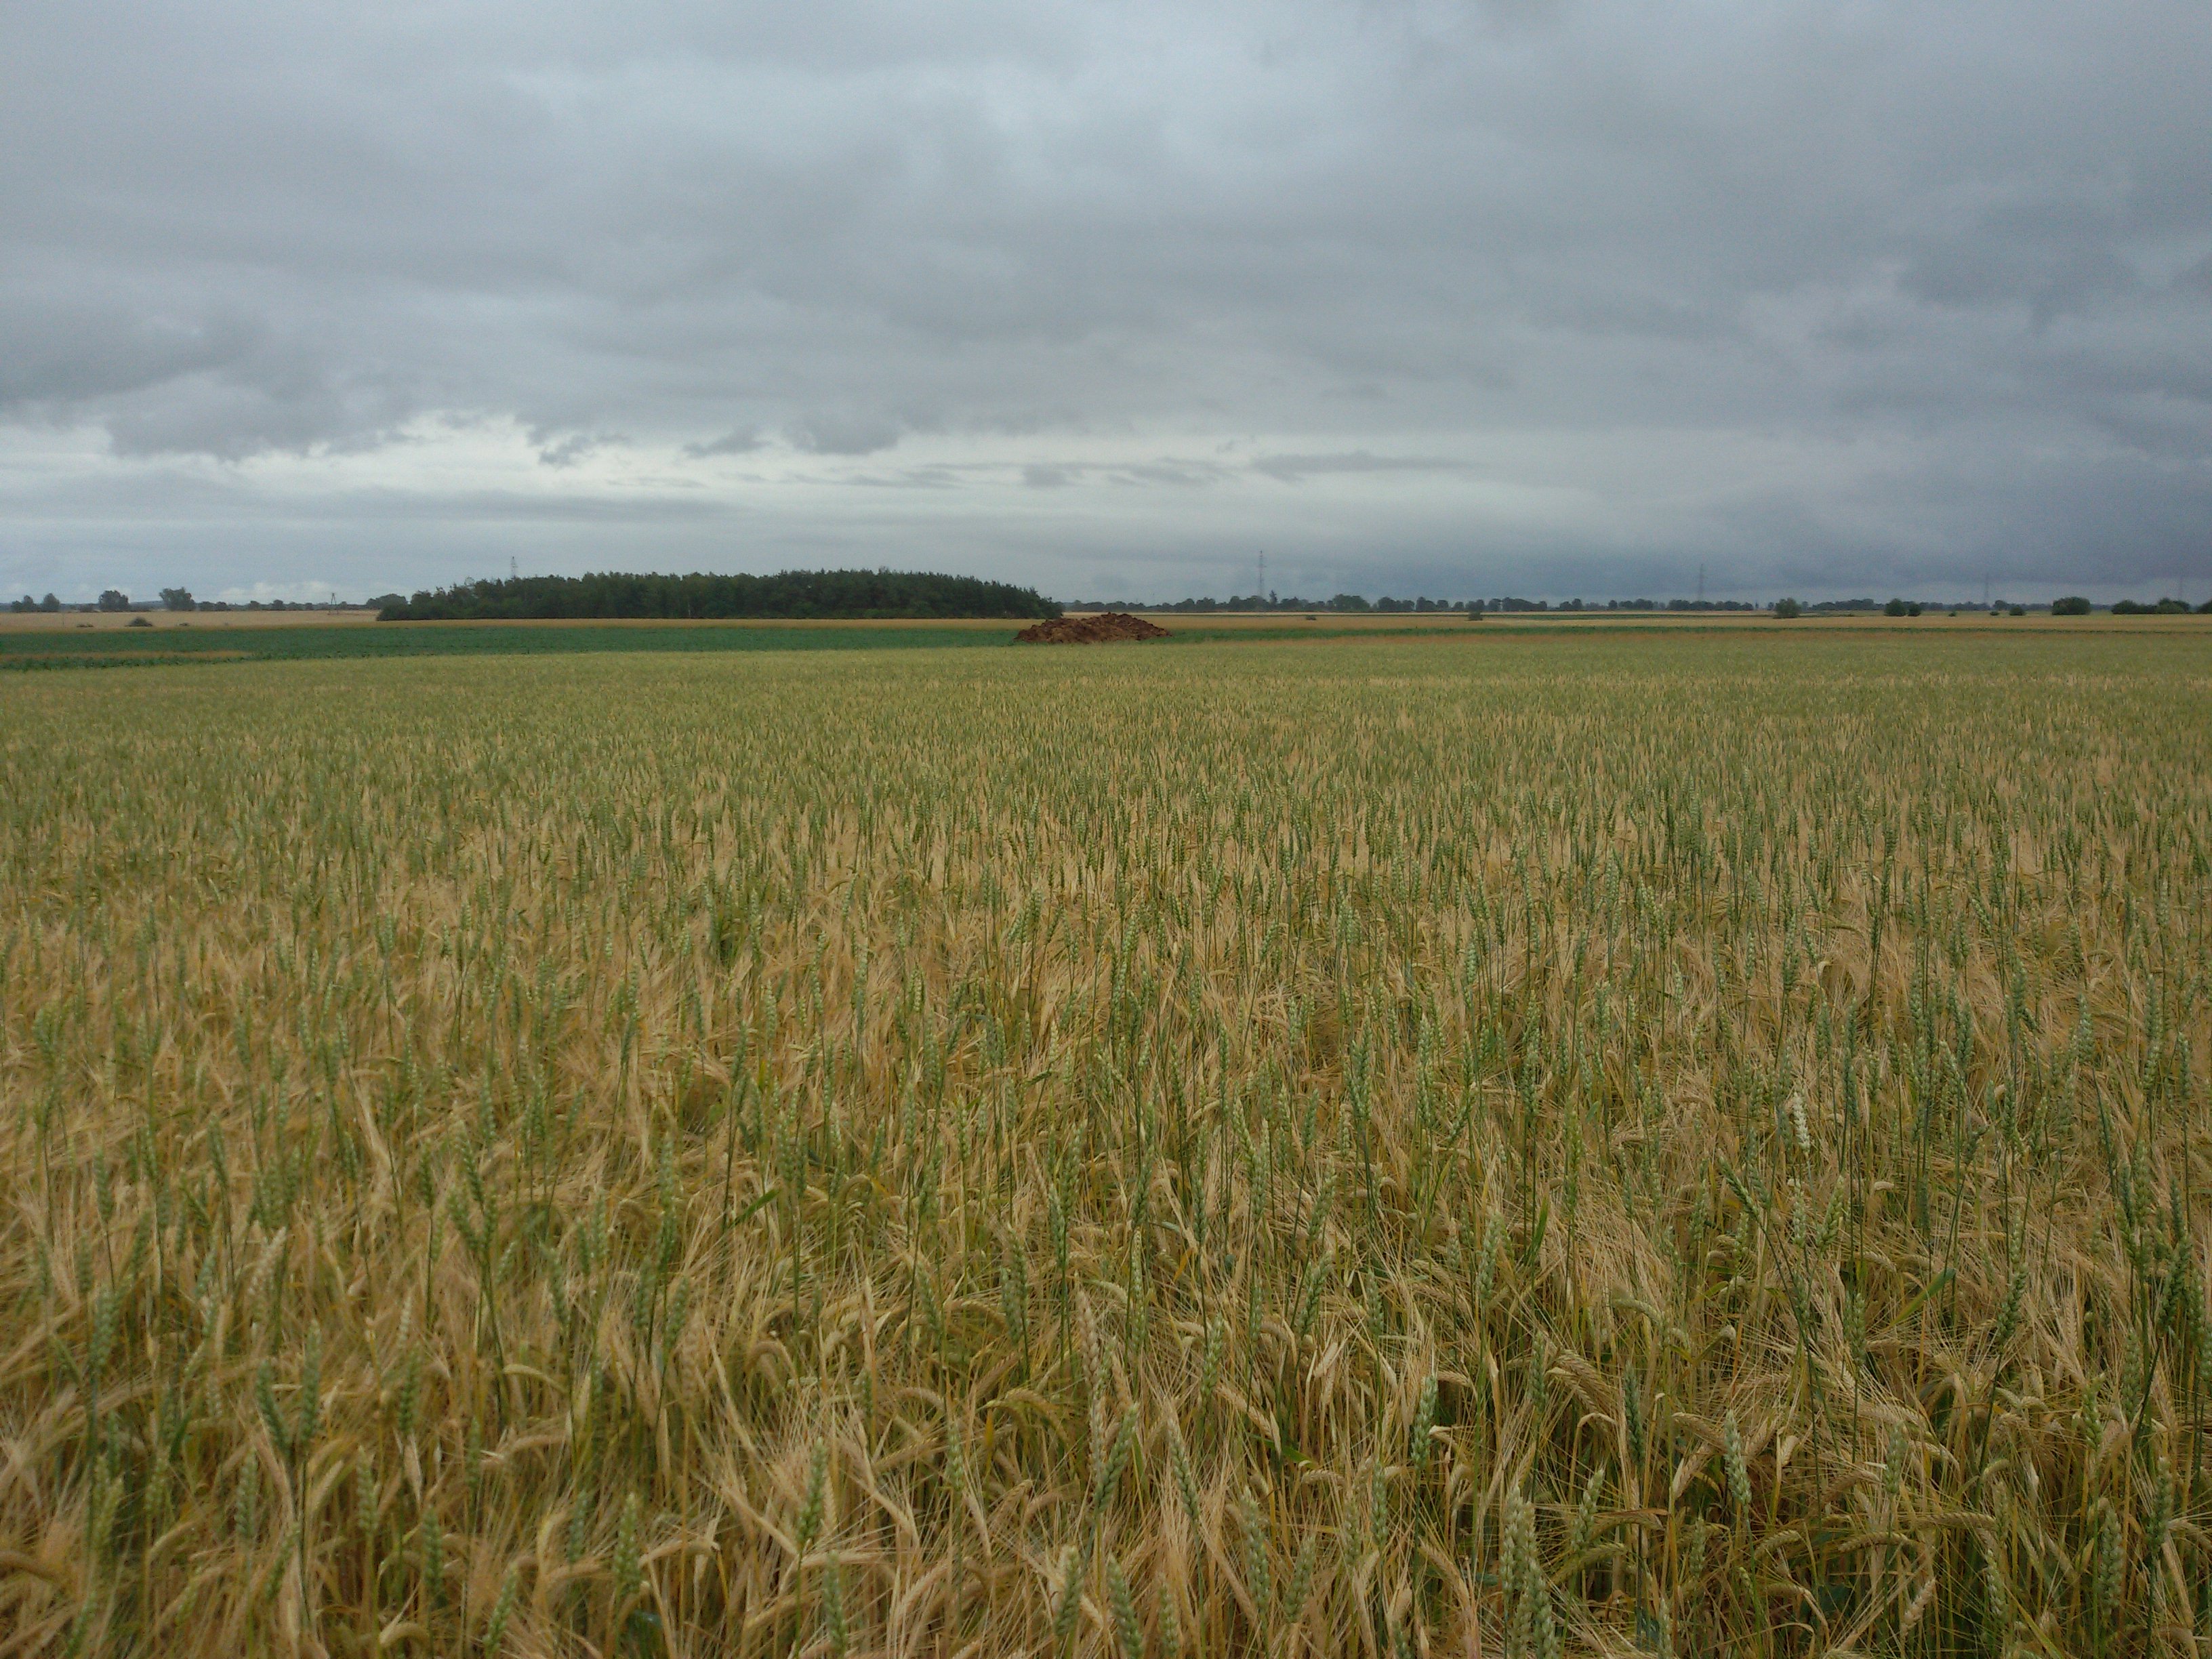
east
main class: Cropland
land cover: Barley
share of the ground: > 75 %
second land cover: Common wheat
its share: > 75 %
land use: Agriculture (excluding fallow land and kitchen gardens)
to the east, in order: Barley; Common wheat; Barley; Maize; Common wheat; Maize; Rape and turnip rape
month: July
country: PL
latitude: 52.8897
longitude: 17.6376
